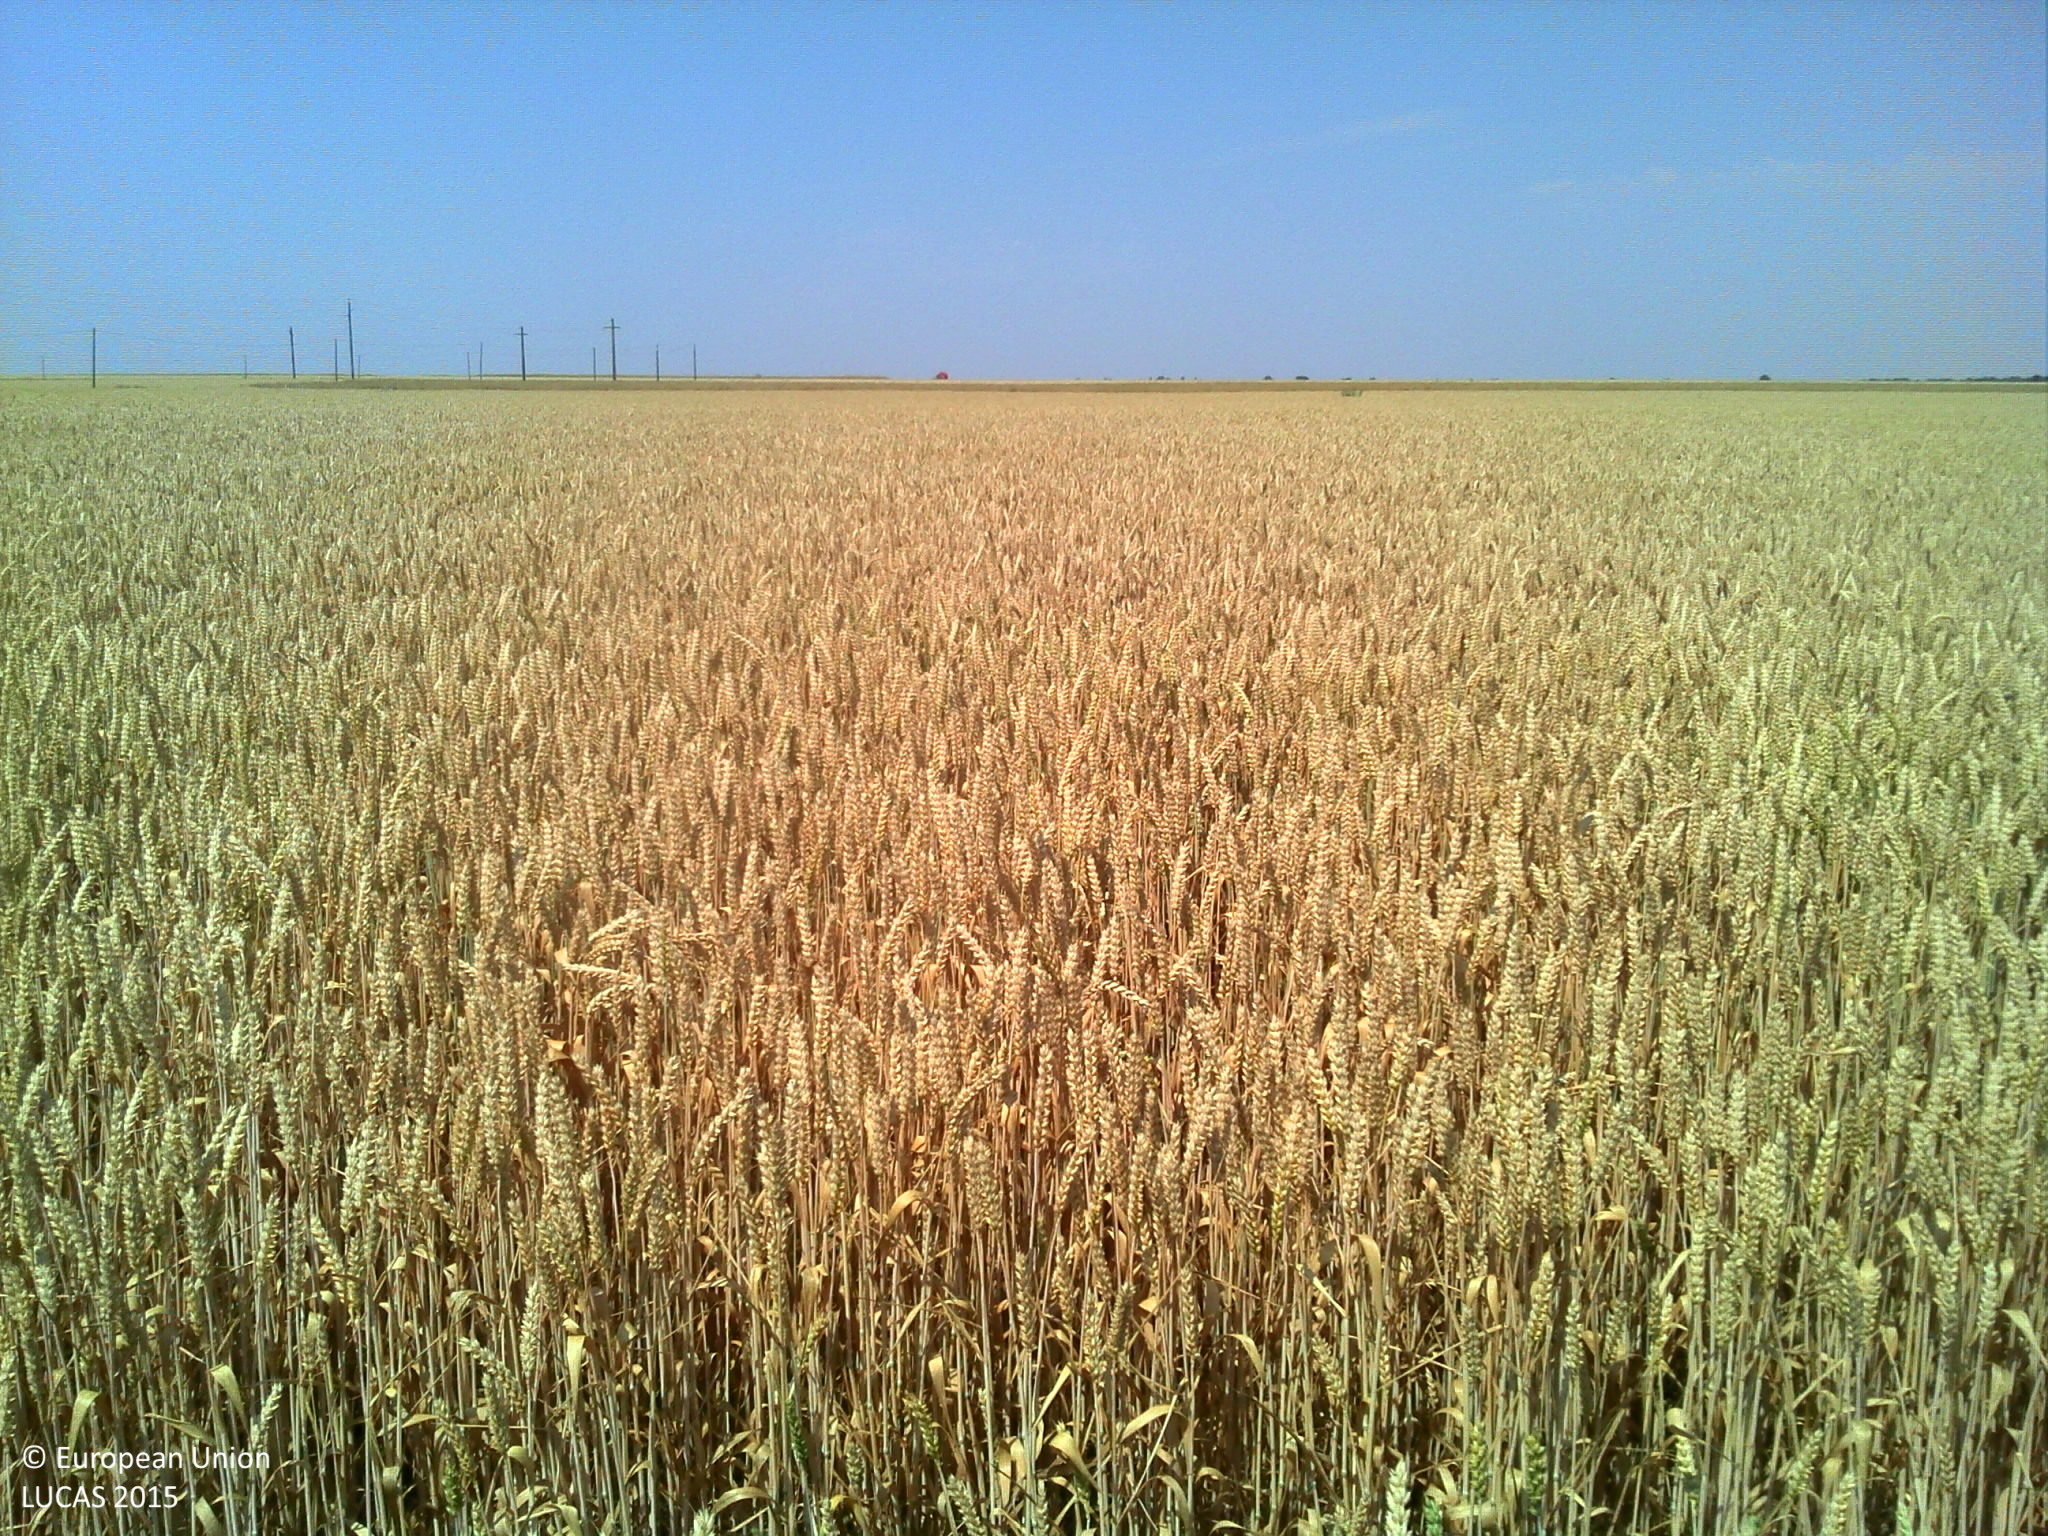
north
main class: Cropland
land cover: Common wheat
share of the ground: > 75 %
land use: Agriculture (excluding fallow land and kitchen gardens)
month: July
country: FR
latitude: 48.9118
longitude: 1.3166
